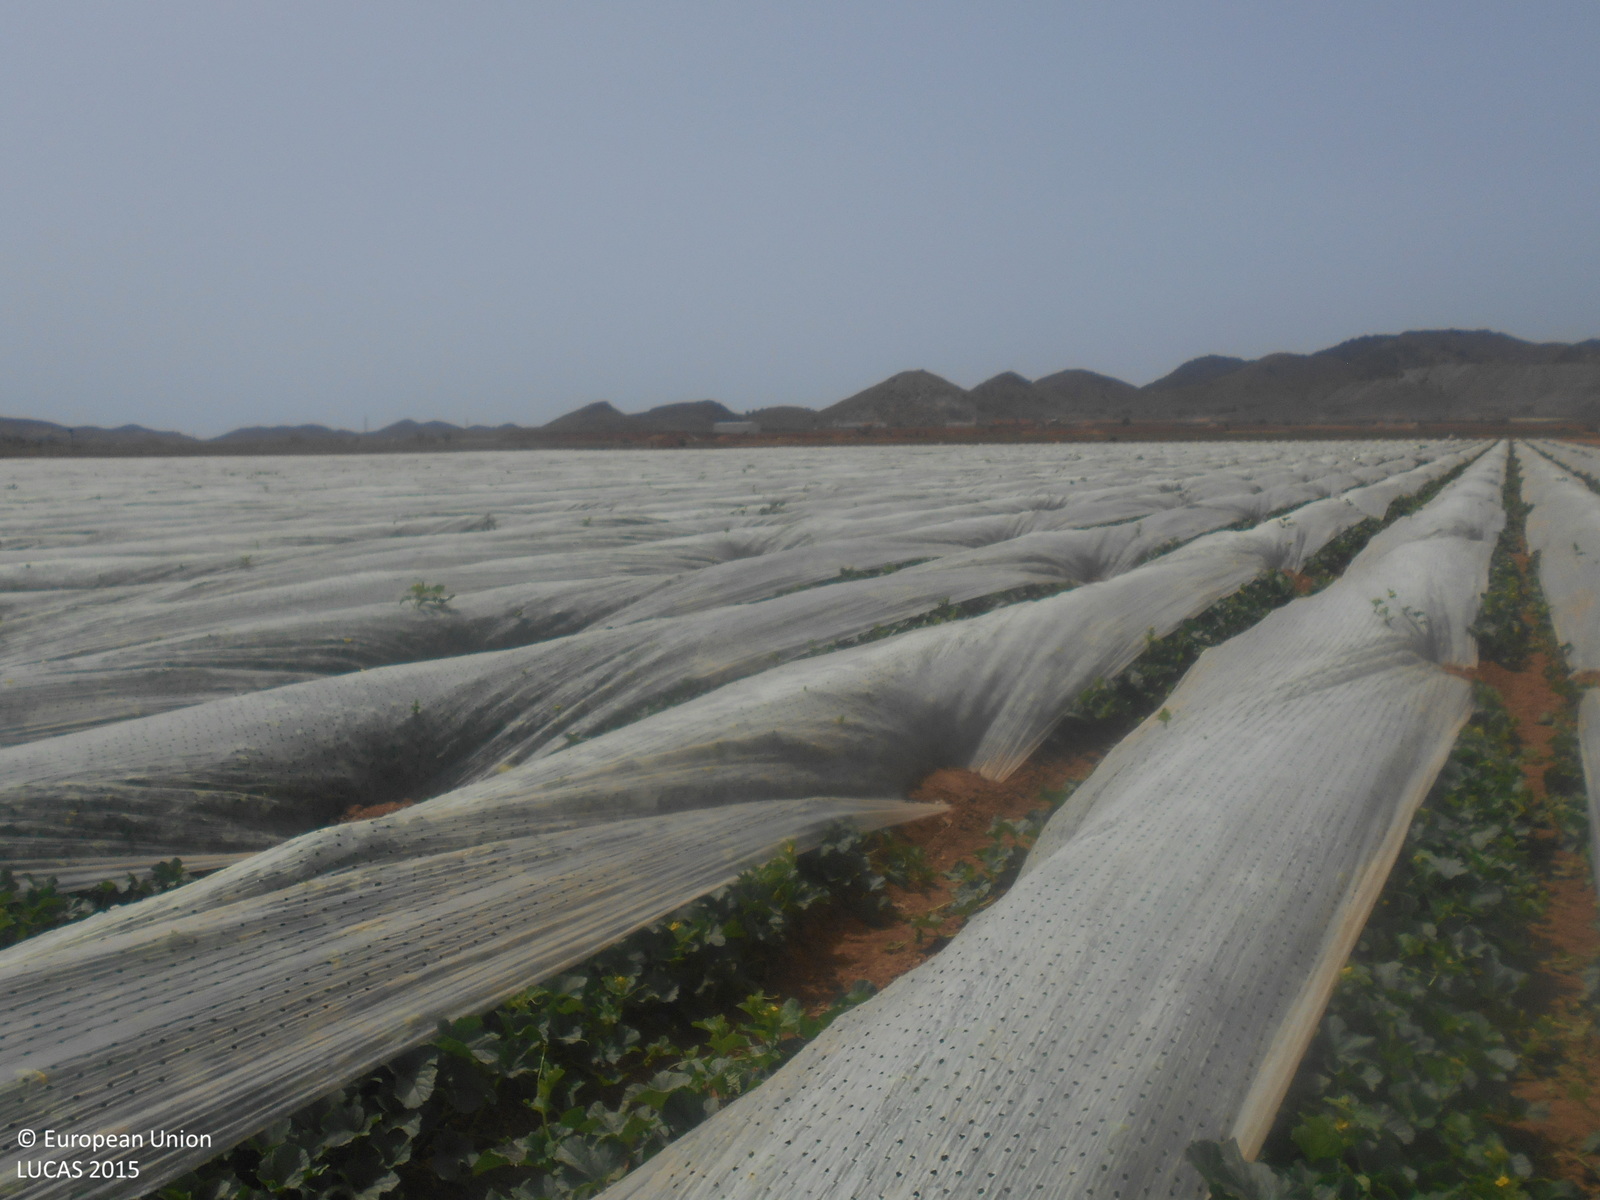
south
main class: Cropland
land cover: Other fresh vegetables
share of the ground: > 75 %
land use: Agriculture (excluding fallow land and kitchen gardens)
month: May
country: ES
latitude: 37.6423
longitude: -0.8014
